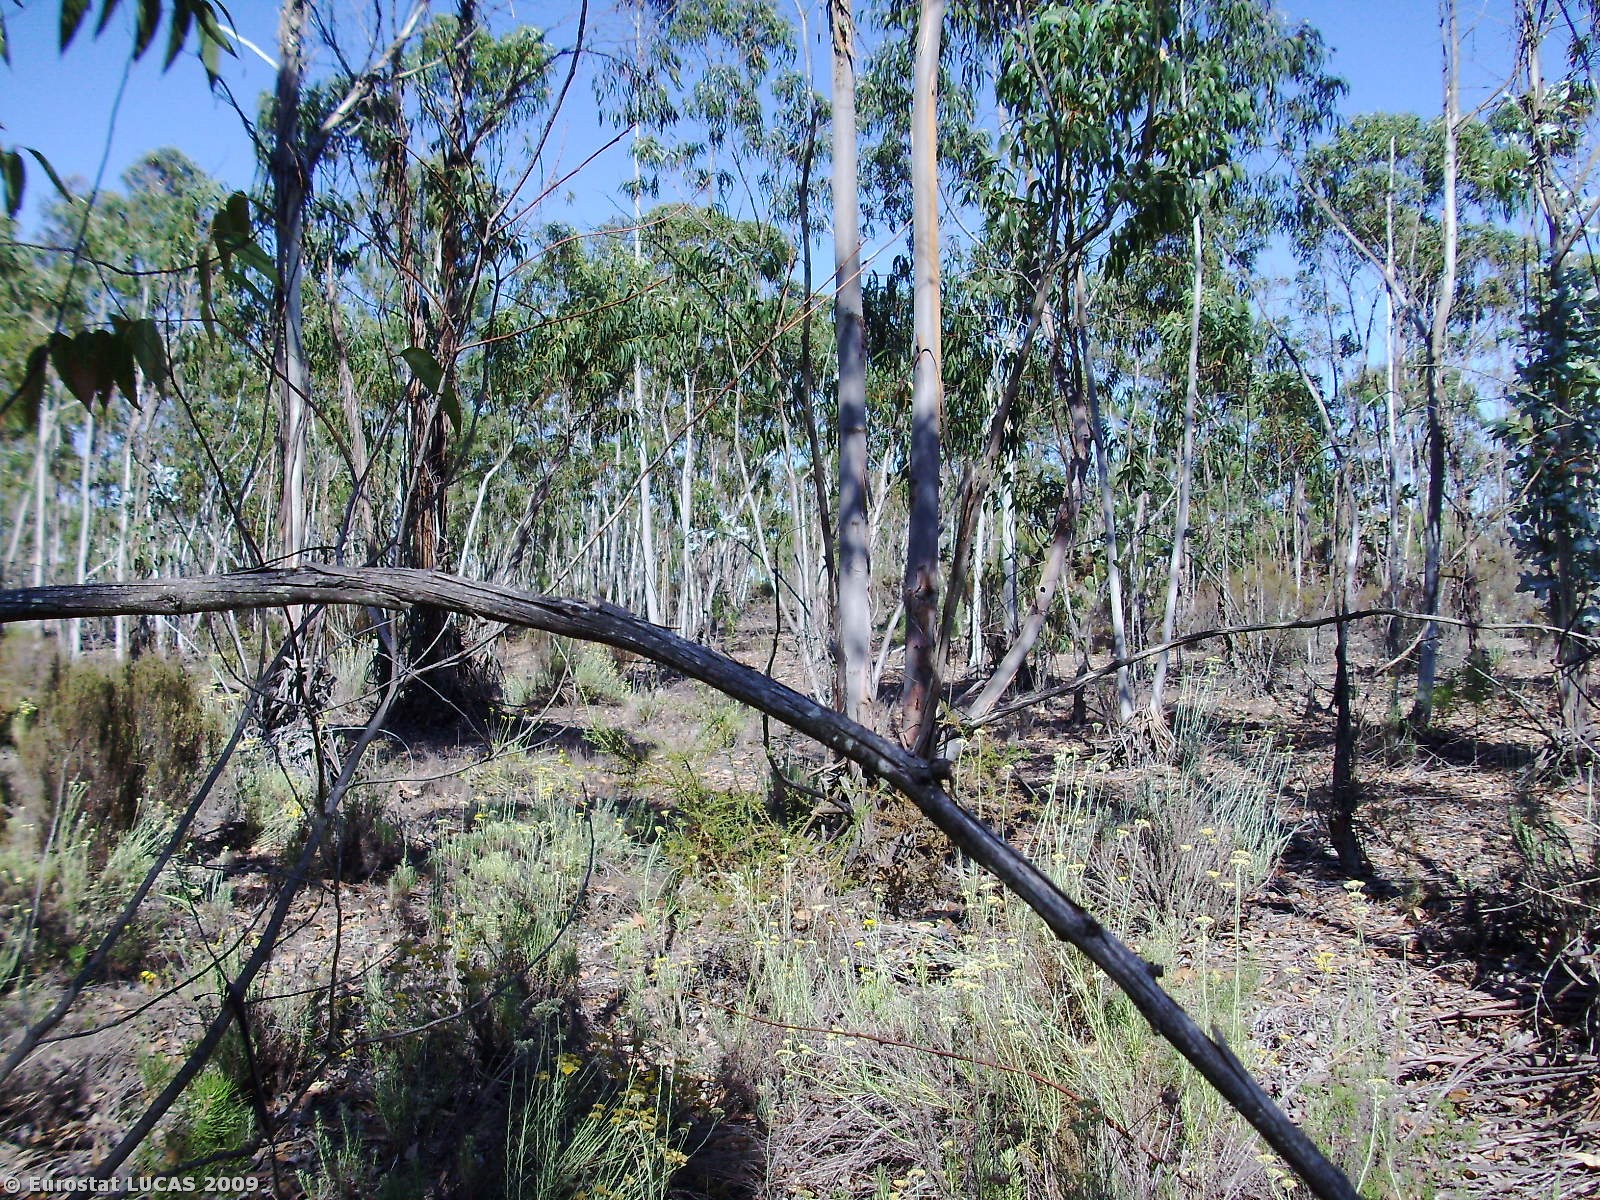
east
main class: Woodland
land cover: Broadleaved woodland
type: plantations and self-sown exotic forest
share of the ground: 50 - 75 %
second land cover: Shrubland with sparse tree cover
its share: 25 - 50 %
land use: Forestry
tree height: > 5 m
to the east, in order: Broadleaved woodland; Shrubland with sparse tree cover; Broadleaved woodland; Shrubland with sparse tree cover; Tracks; Broadleaved woodland; Shrubland with sparse tree cover
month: June
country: PT
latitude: 38.3108
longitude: -8.6607
